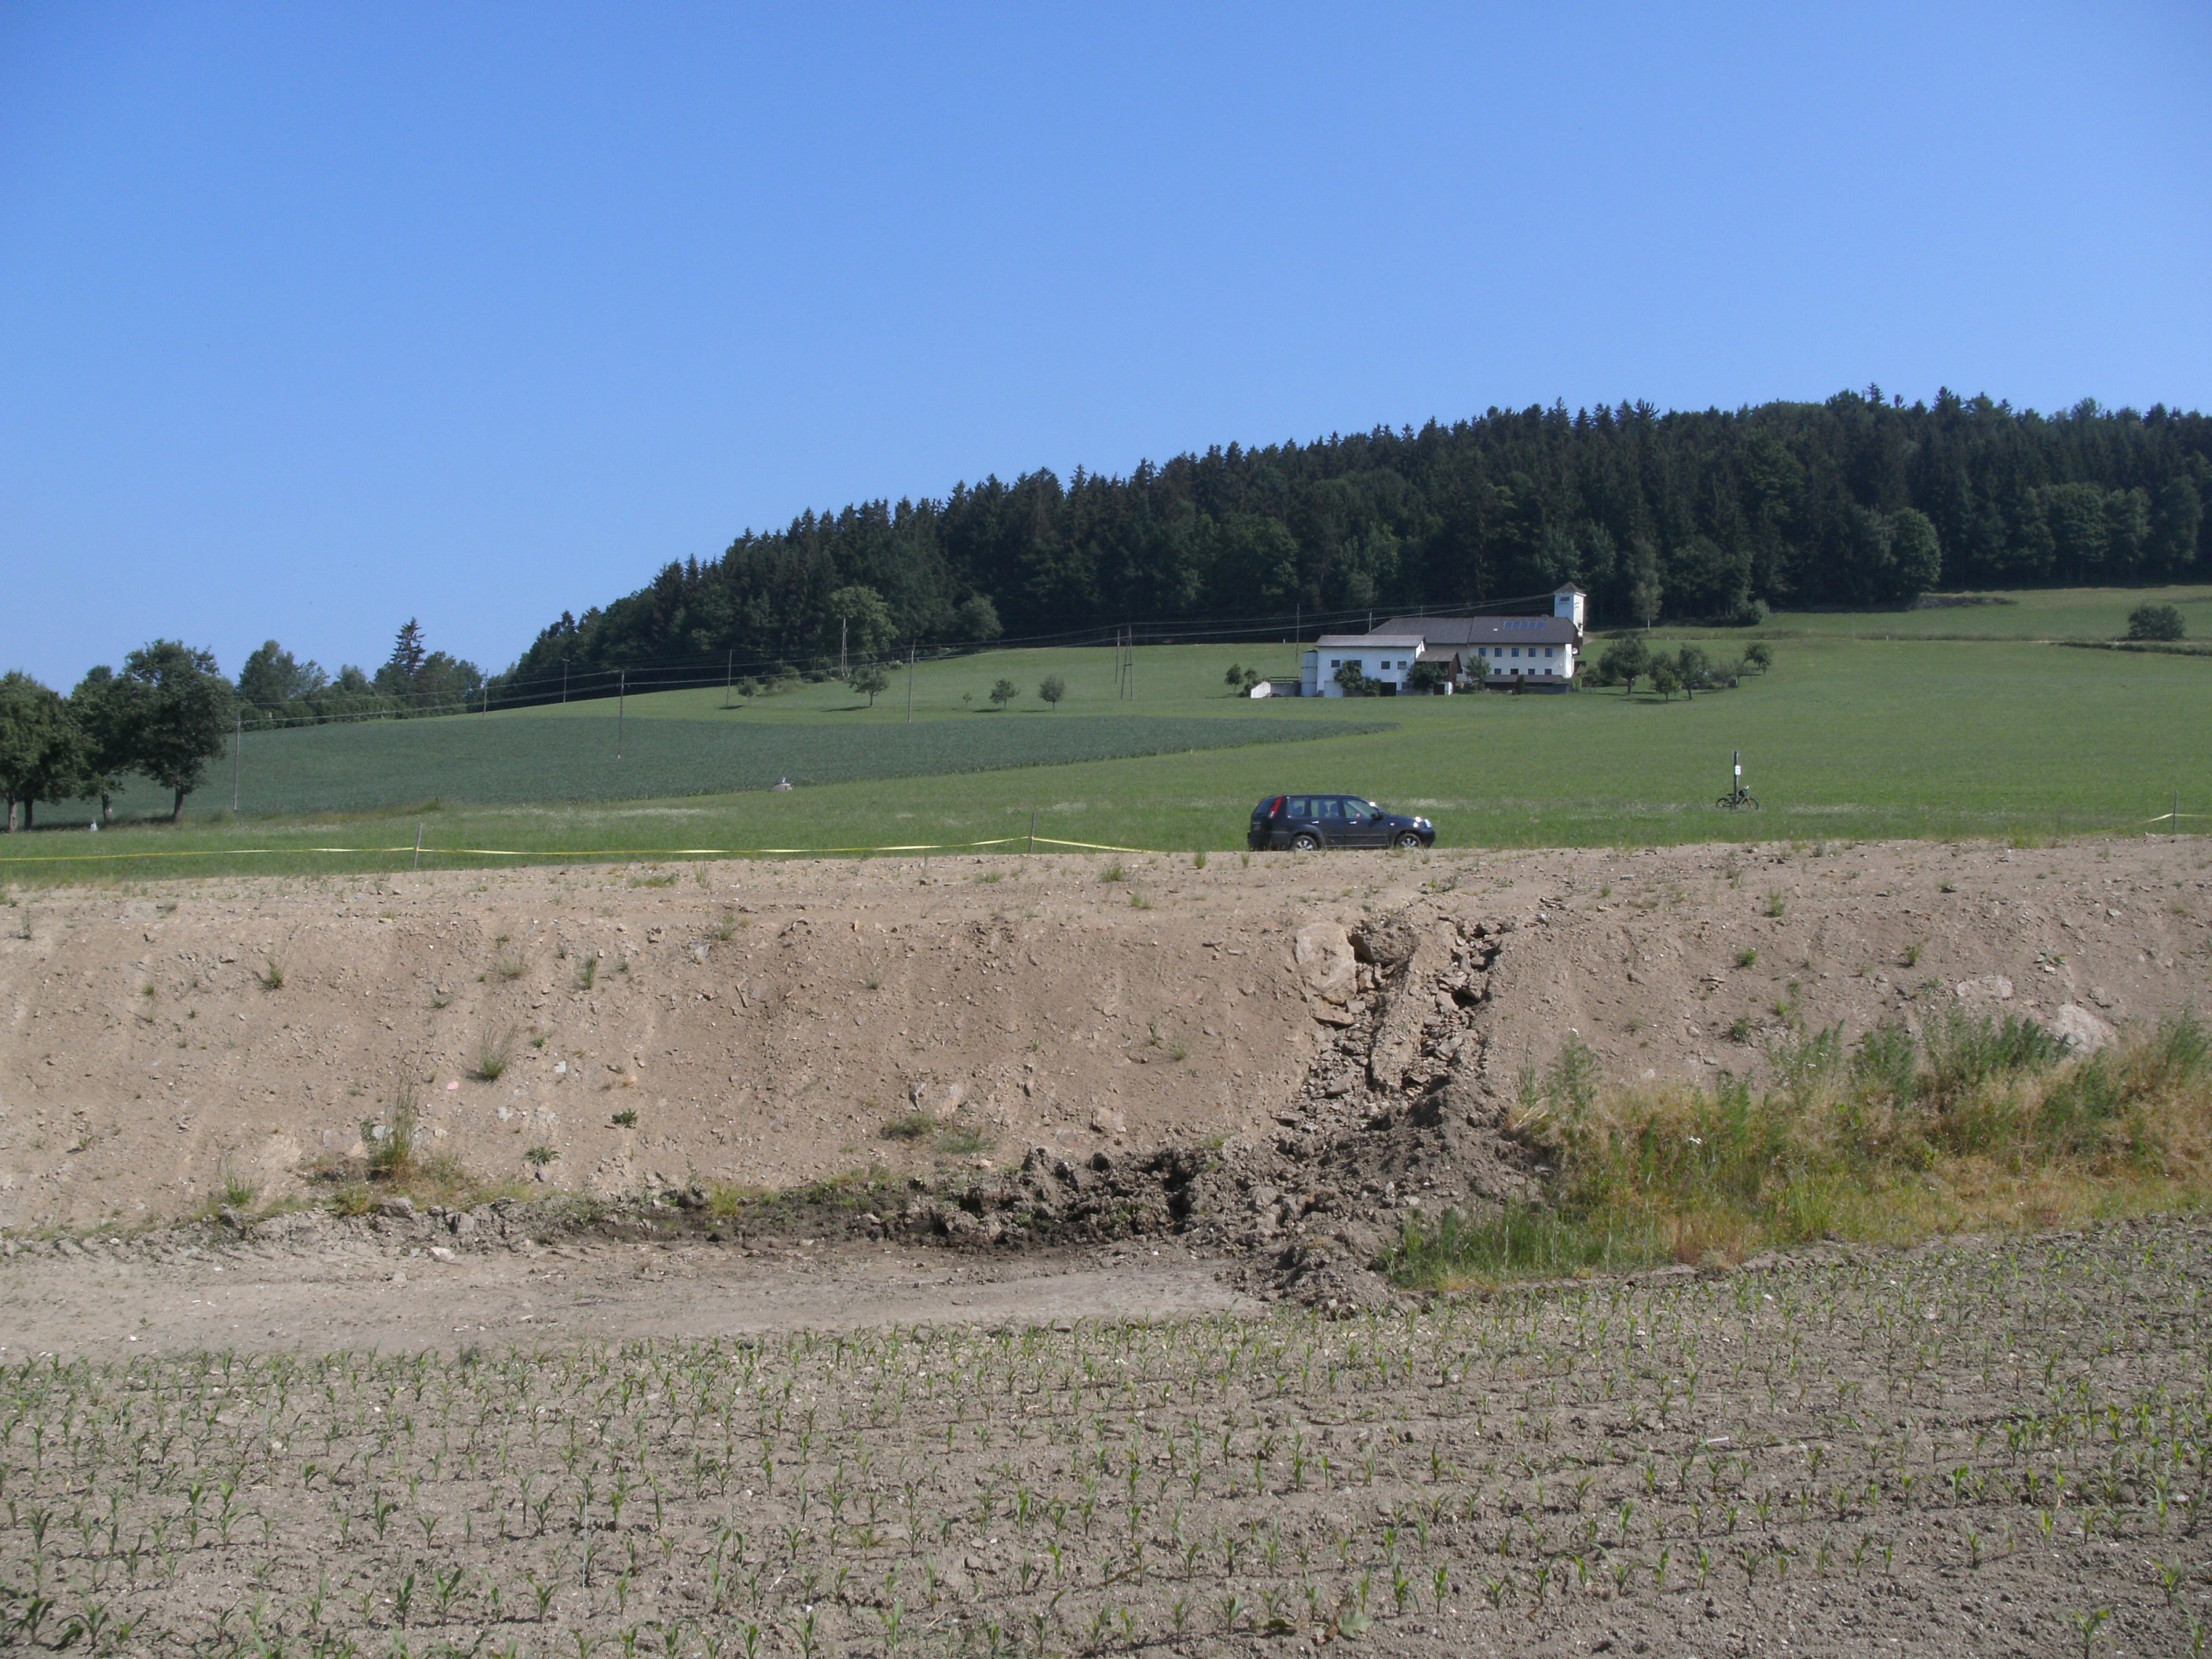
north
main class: Cropland
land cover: Maize
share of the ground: 10 - 25 %
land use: Agriculture (excluding fallow land and kitchen gardens)
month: June
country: AT
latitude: 48.3948
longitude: 14.2275
